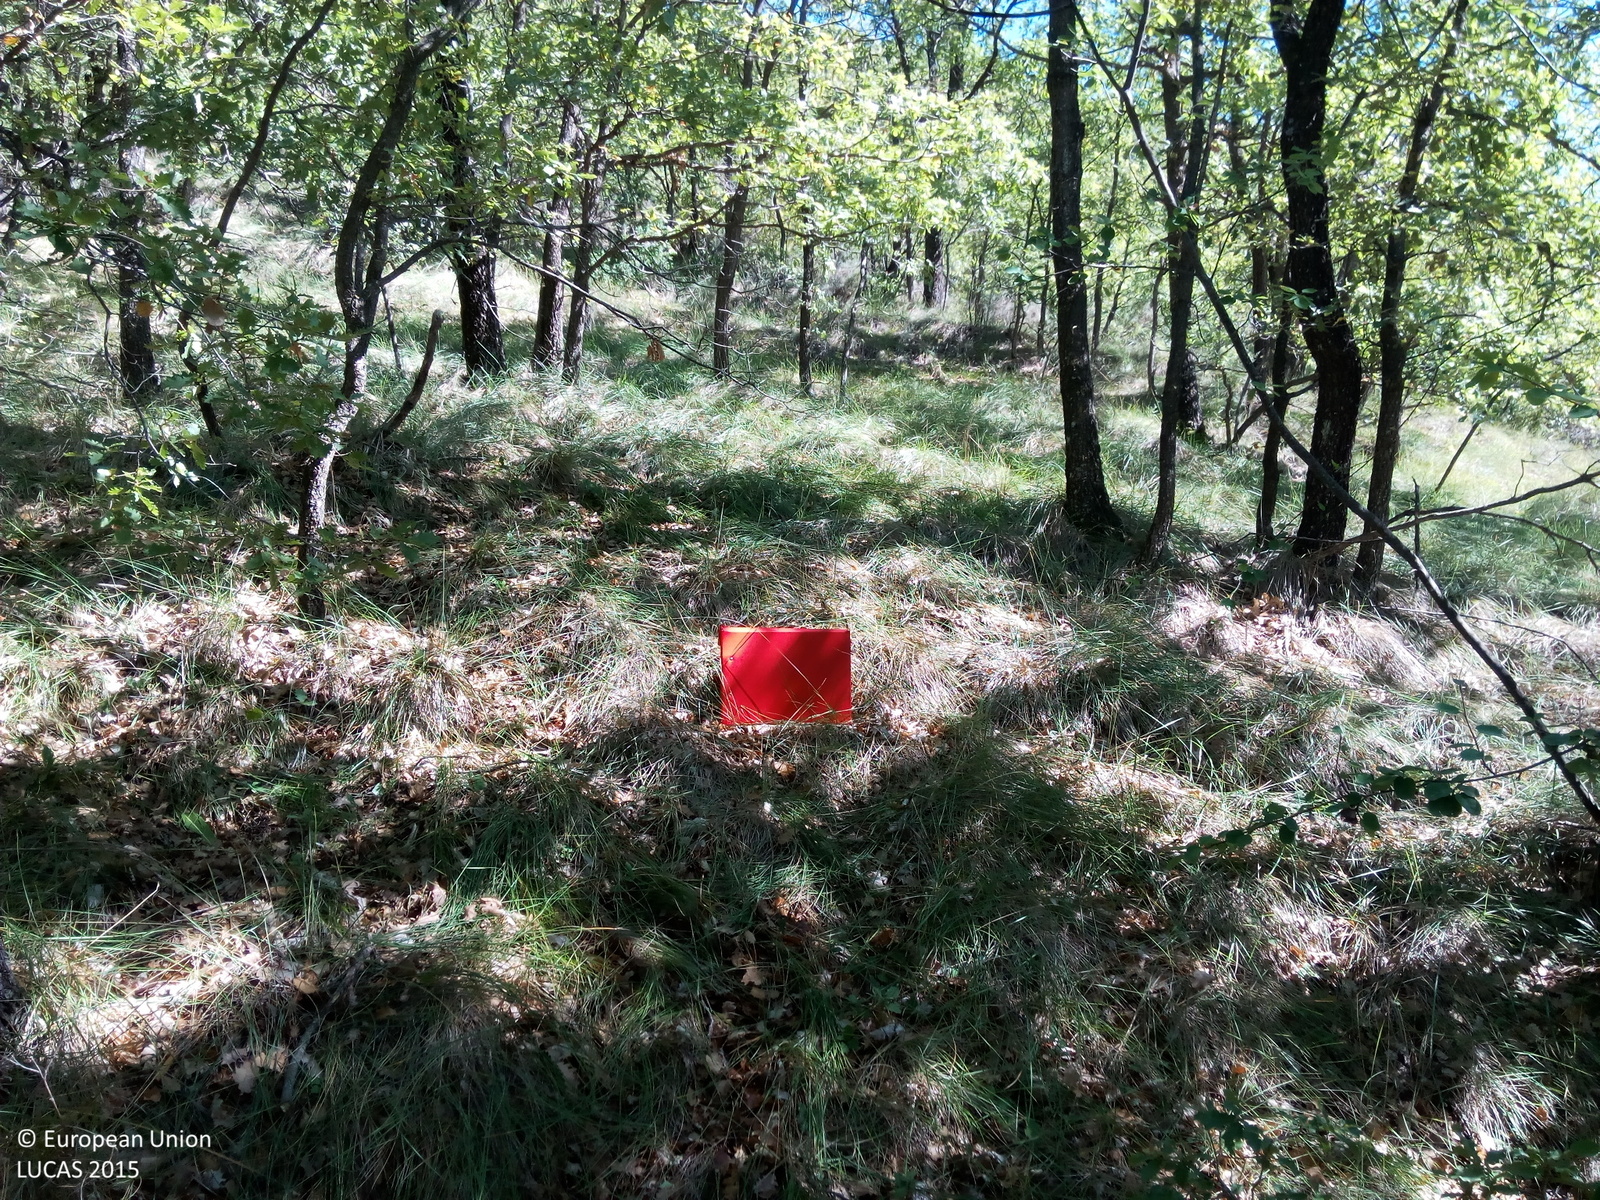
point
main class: Woodland
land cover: Broadleaved woodland
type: broadleaved evergreen forest
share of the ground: > 75 %
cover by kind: broadleaved forest trees 100 %
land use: Semi-natural and natural areas not in use
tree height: > 5 m
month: September
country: ES
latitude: 42.3409
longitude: 0.5751
